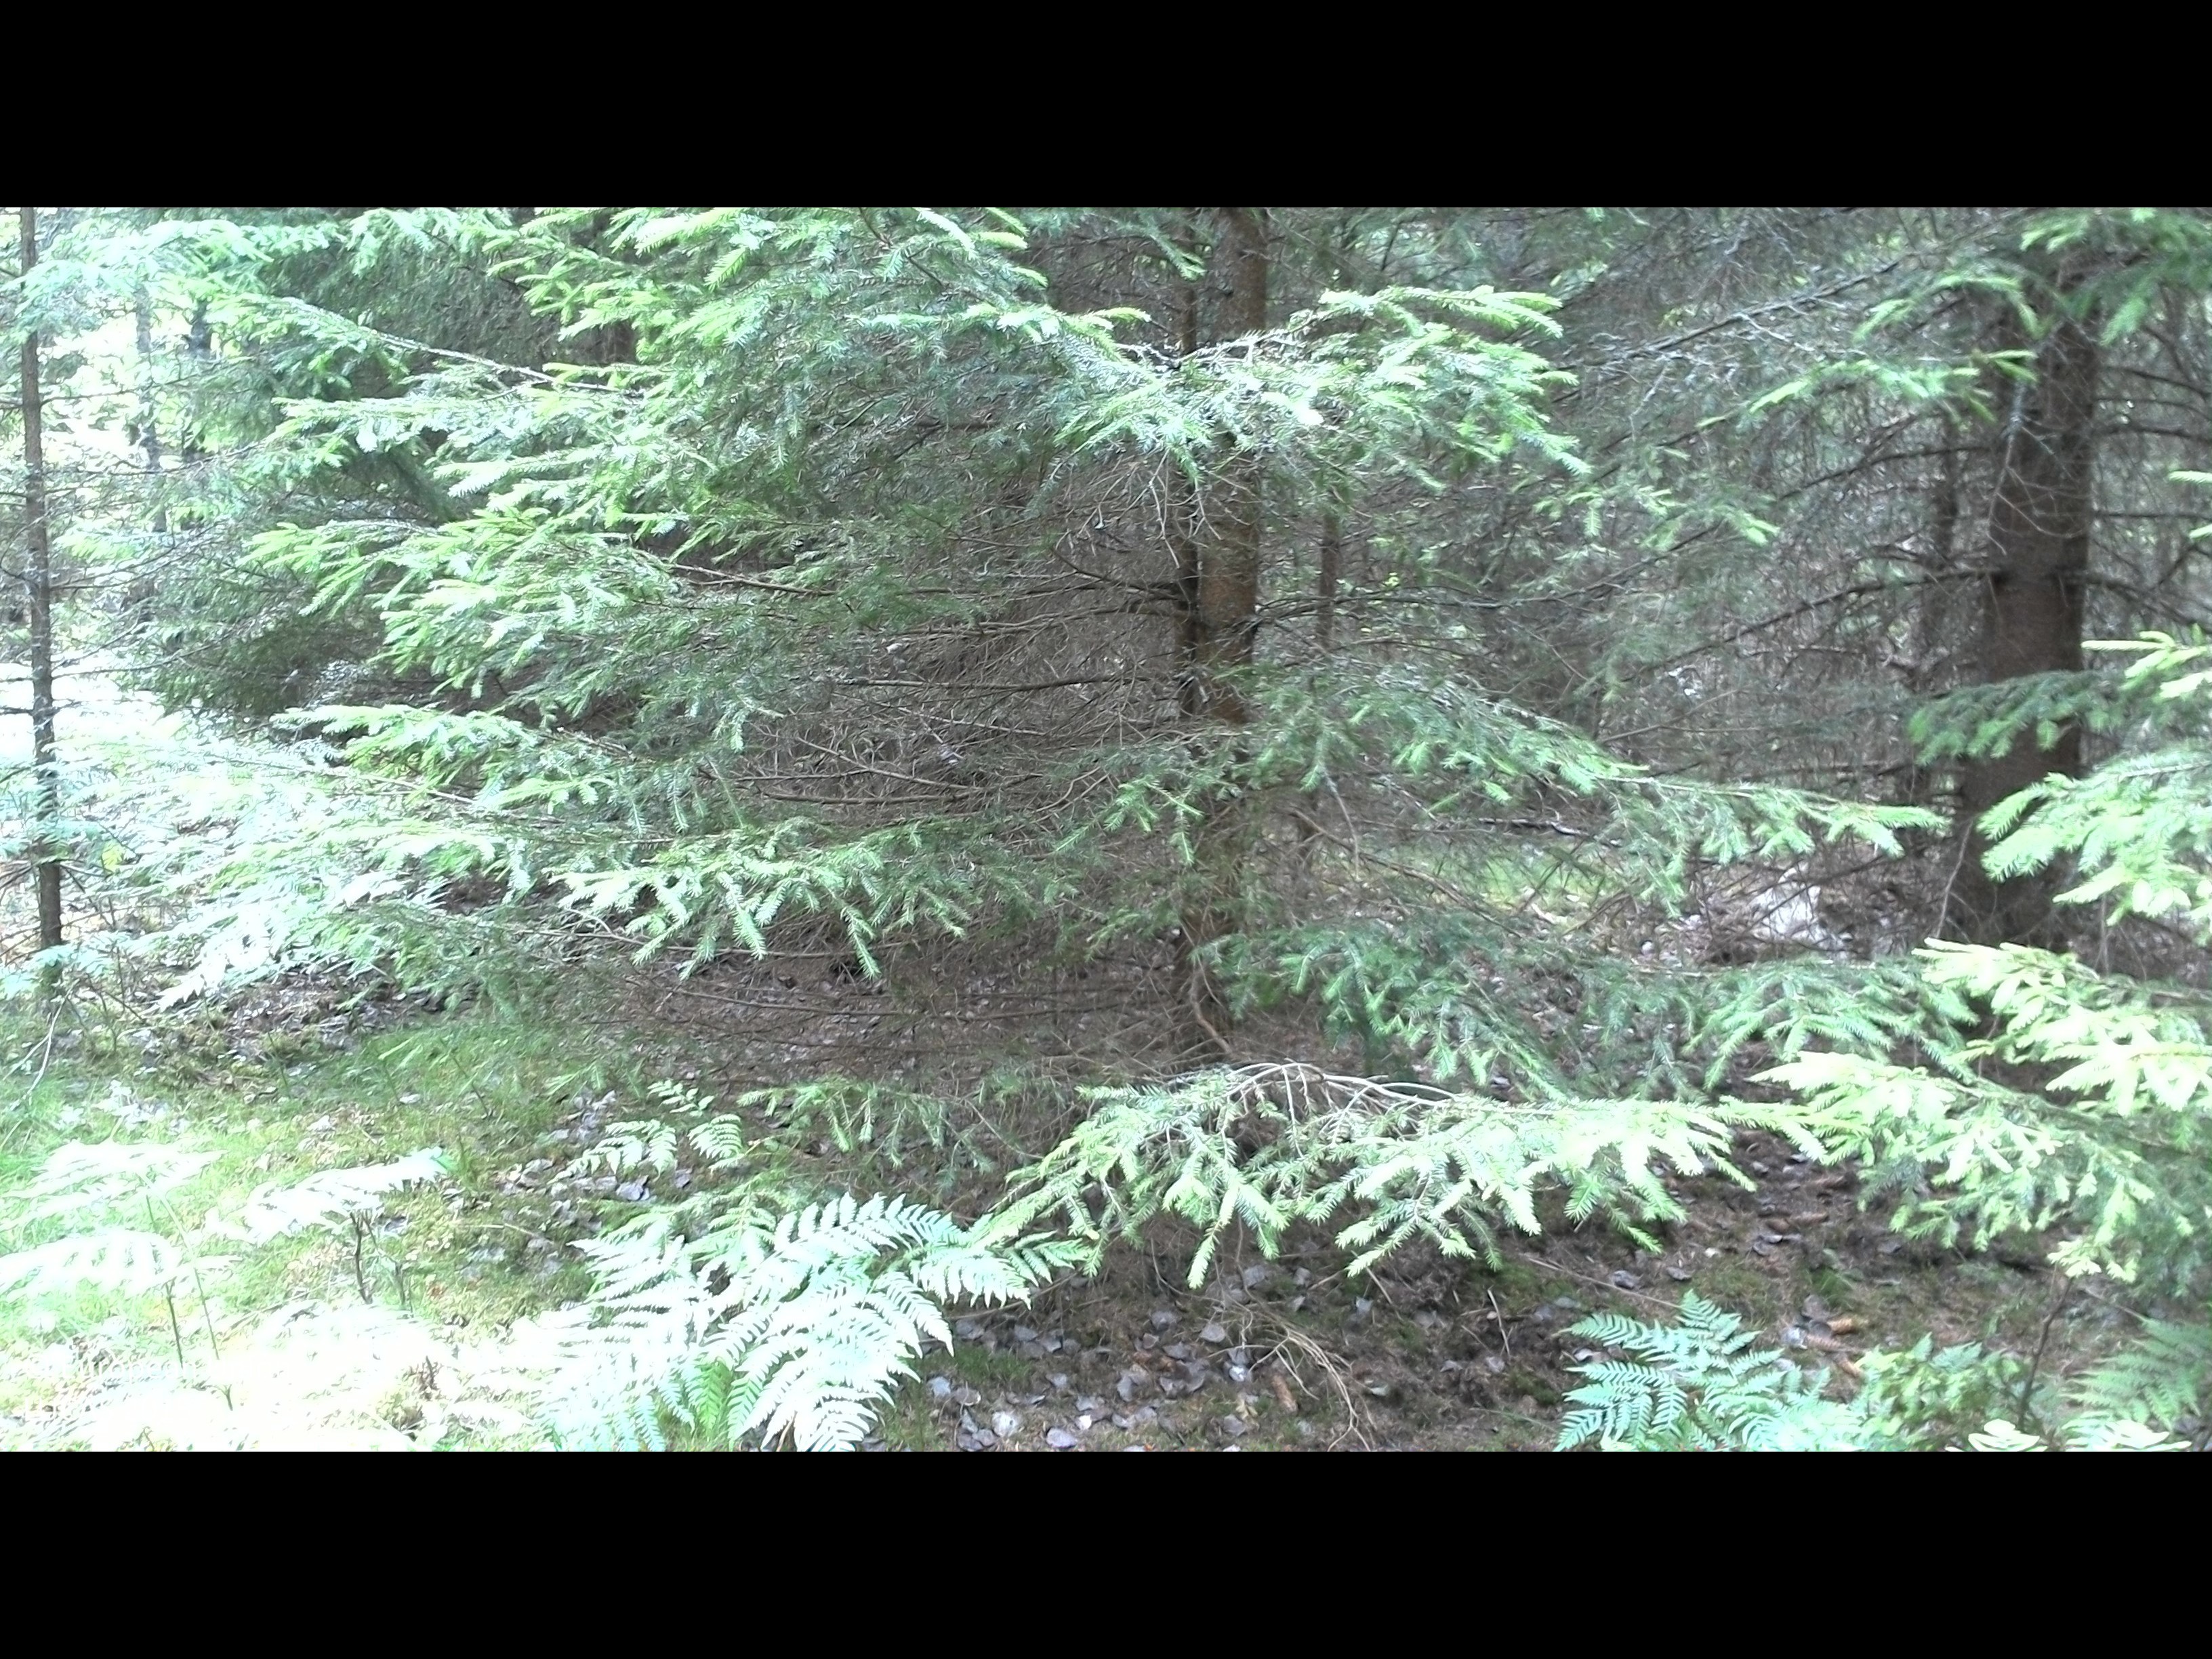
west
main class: Woodland
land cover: Spruce dominated coniferous woodland
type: boreal forest
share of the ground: > 75 %
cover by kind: coniferous forest trees 70 %, herbaceous plants 15 %, broadleaved forest trees 5 %, shrubs 5 %, lichens and mosses 5 %
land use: Forestry
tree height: > 5 m
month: July
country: SE
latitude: 56.4768
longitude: 14.7873
